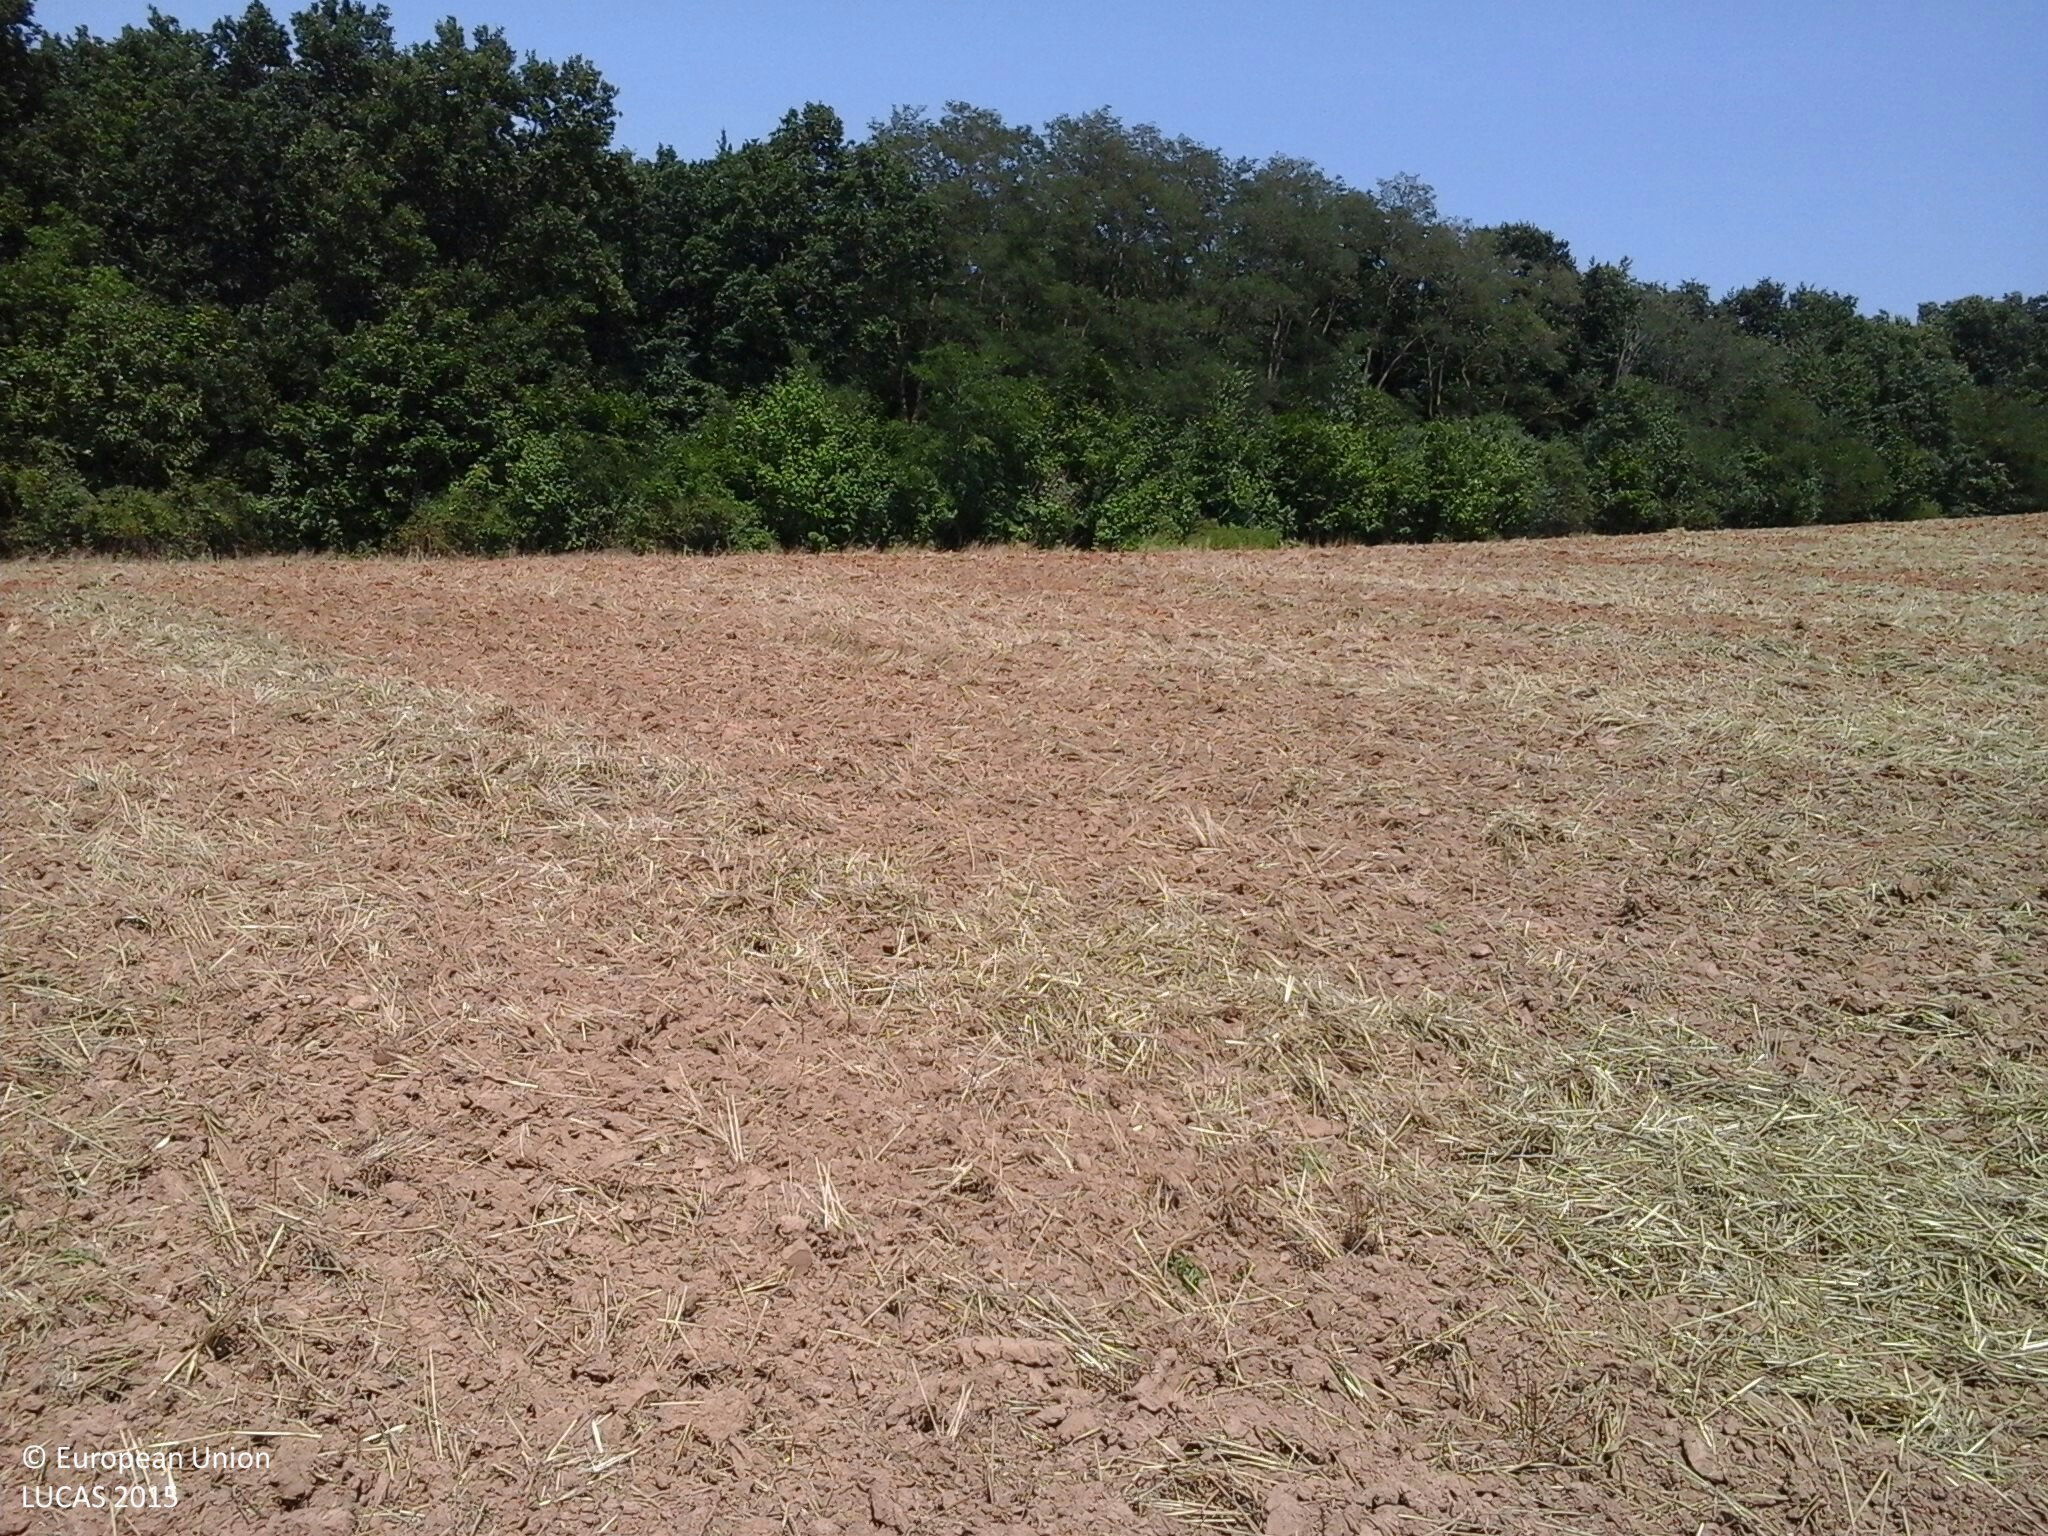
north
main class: Cropland
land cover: Common wheat
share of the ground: < 10 %
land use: Agriculture (excluding fallow land and kitchen gardens)
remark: Harvested field
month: August
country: HU
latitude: 48.4167
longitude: 20.8068
